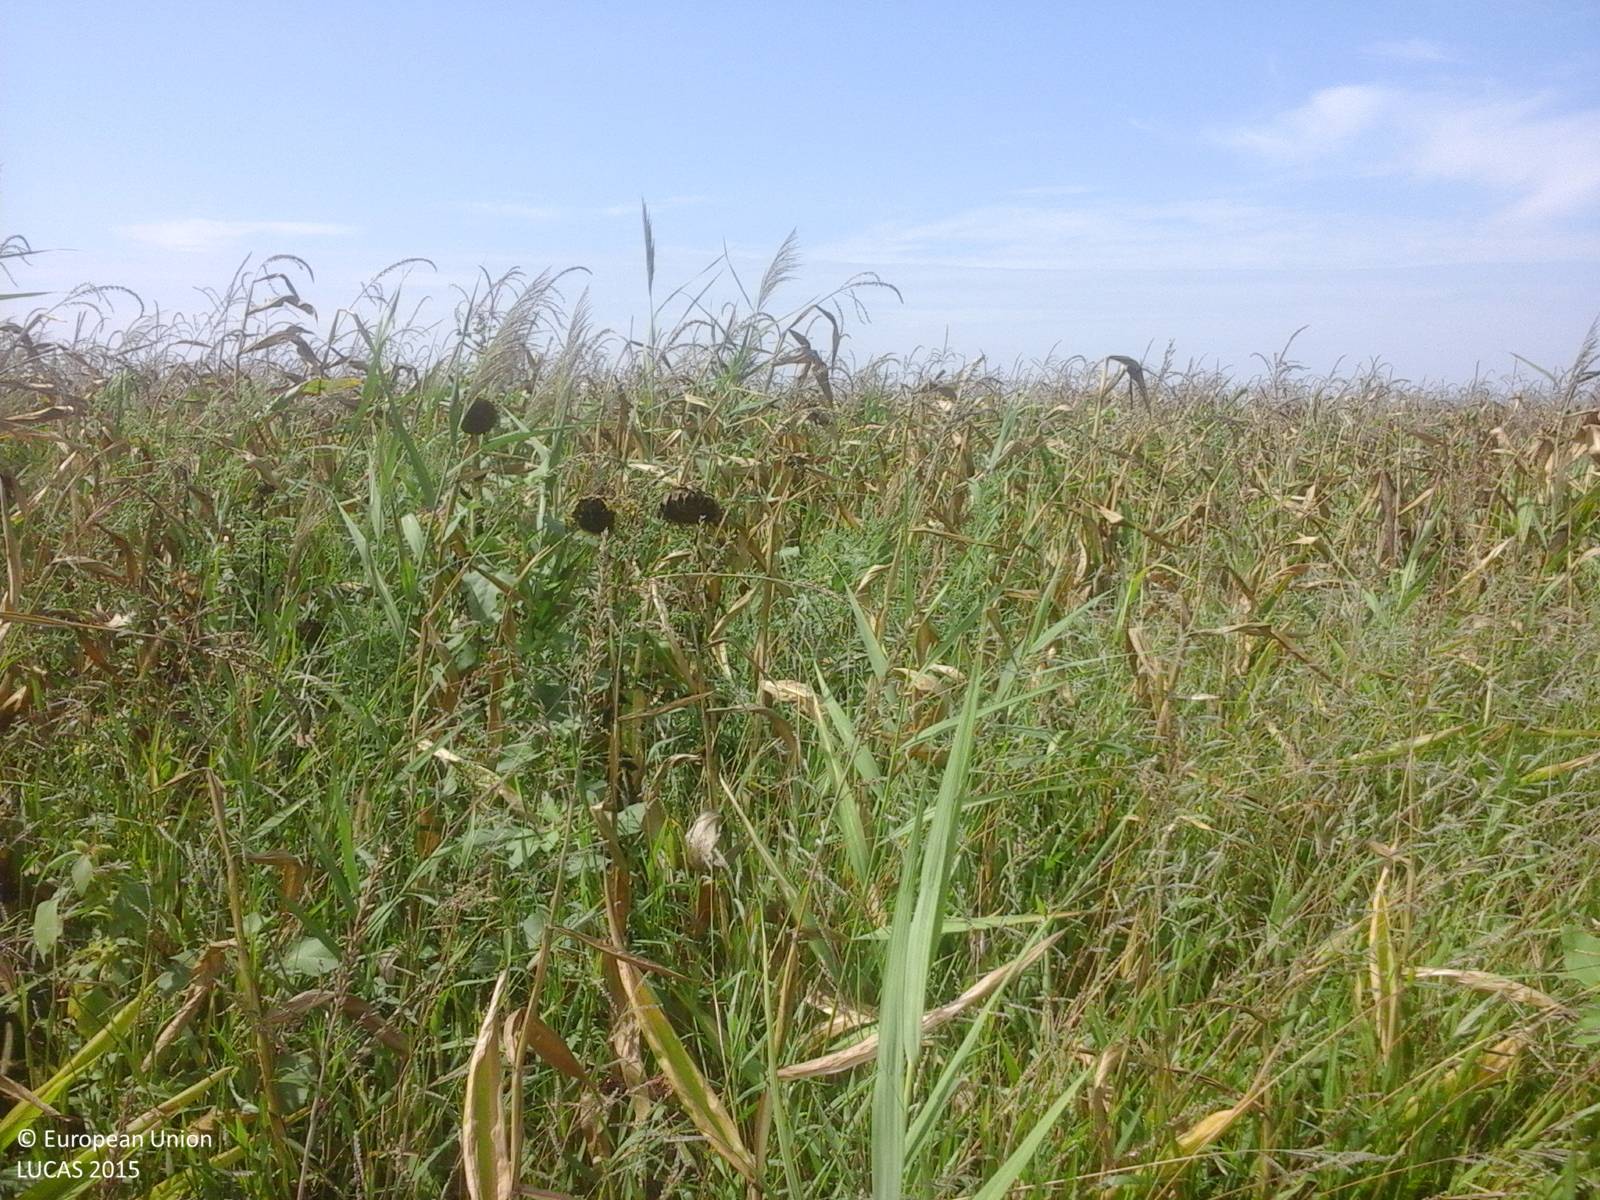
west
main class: Cropland
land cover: Maize
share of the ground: > 75 %
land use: Agriculture (excluding fallow land and kitchen gardens)
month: August
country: RO
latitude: 46.4485
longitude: 21.4010
